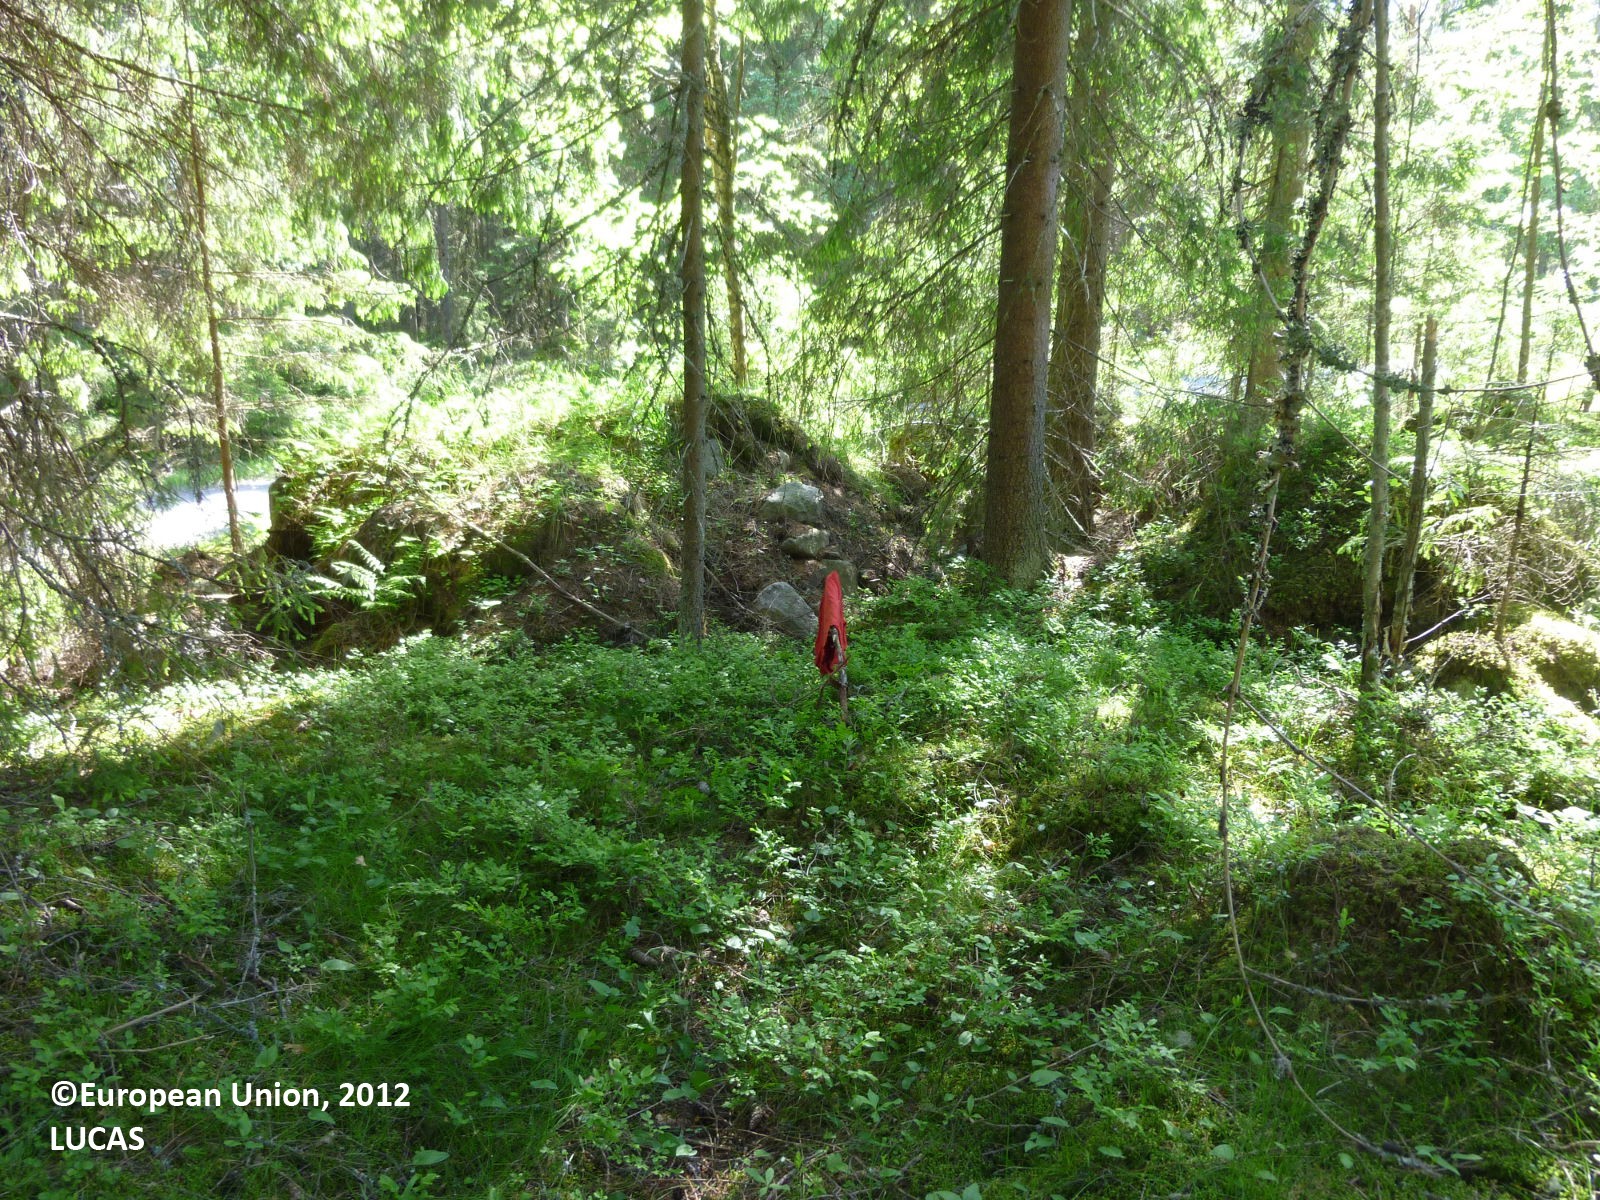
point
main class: Woodland
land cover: Spruce dominated coniferous woodland
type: boreal forest
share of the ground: > 75 %
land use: Forestry
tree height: > 5 m
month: June
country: FI
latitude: 61.4940
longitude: 22.8220
